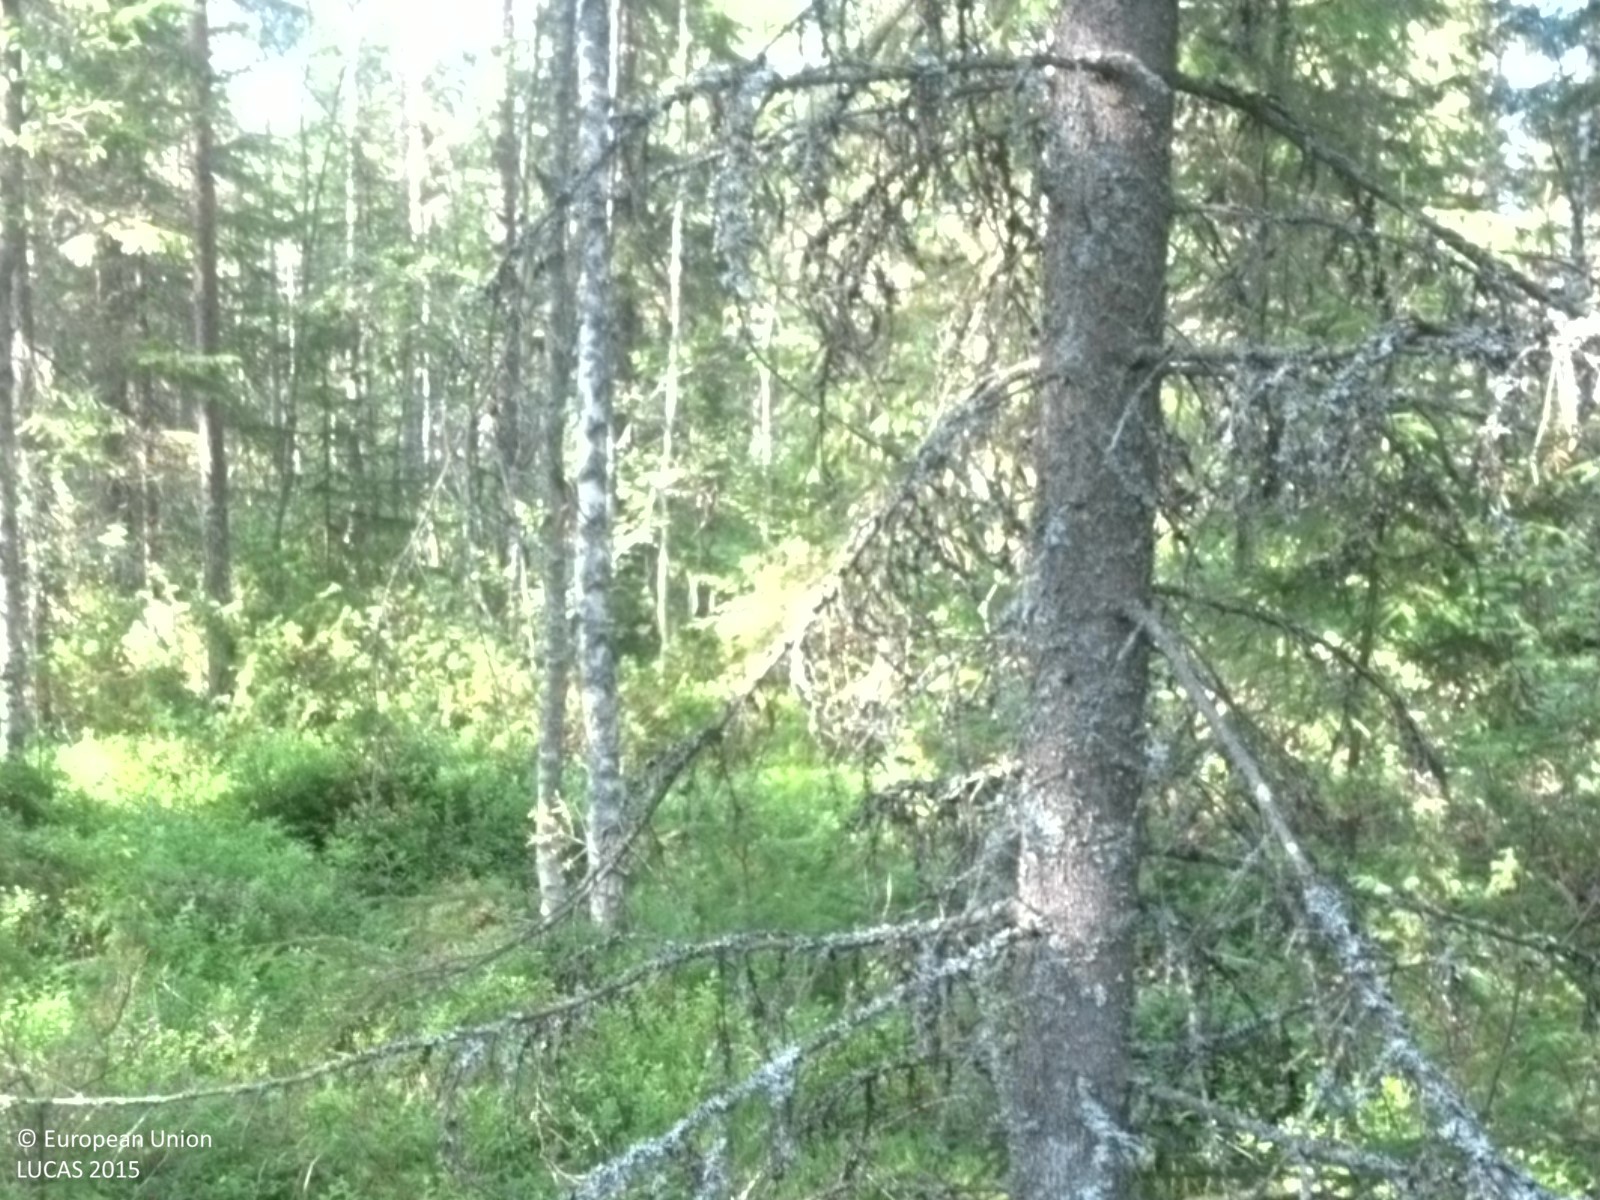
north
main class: Woodland
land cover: Other mixed woodland
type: boreal forest
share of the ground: 50 - 75 %
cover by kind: coniferous forest trees 40 %, herbaceous plants 30 %, broadleaved forest trees 20 %, shrubs 10 %
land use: Forestry
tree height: > 5 m
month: July
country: SE
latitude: 63.6868
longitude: 19.9088
